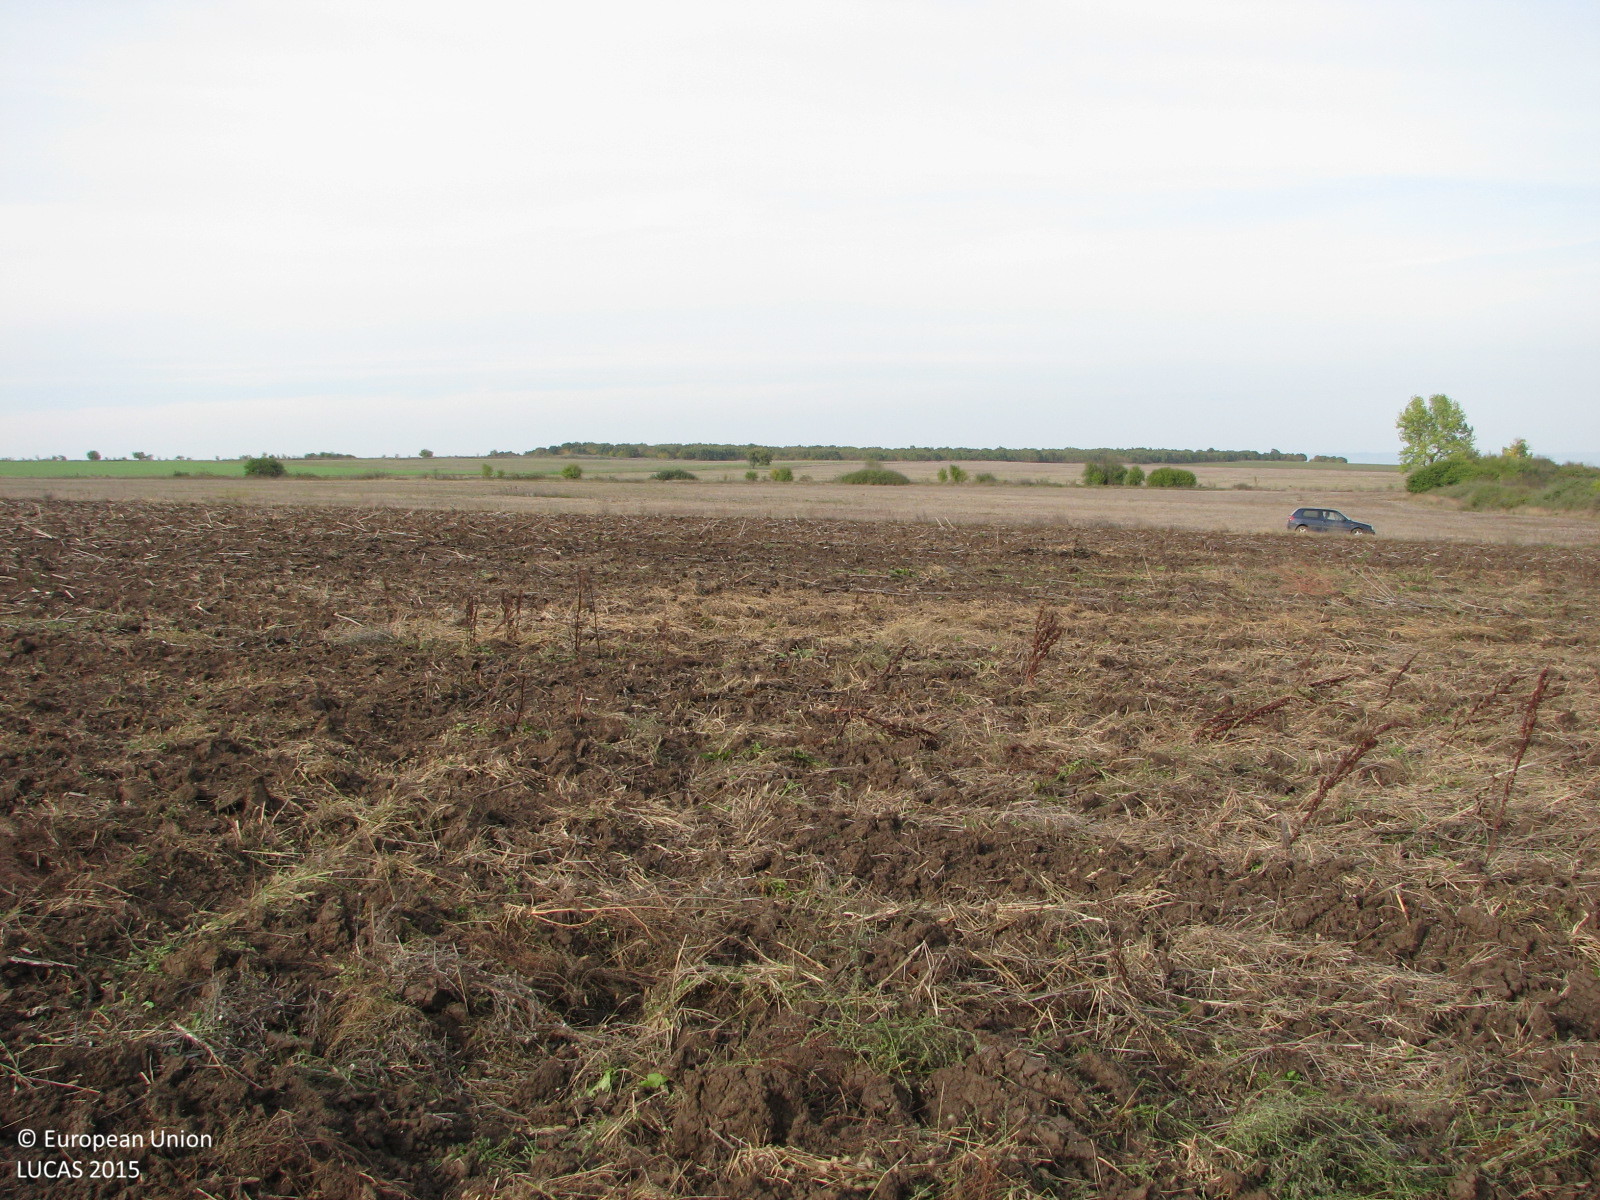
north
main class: Cropland
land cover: Sunflower
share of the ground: < 10 %
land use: Agriculture (excluding fallow land and kitchen gardens)
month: October
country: BG
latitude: 42.5018
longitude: 26.7328
